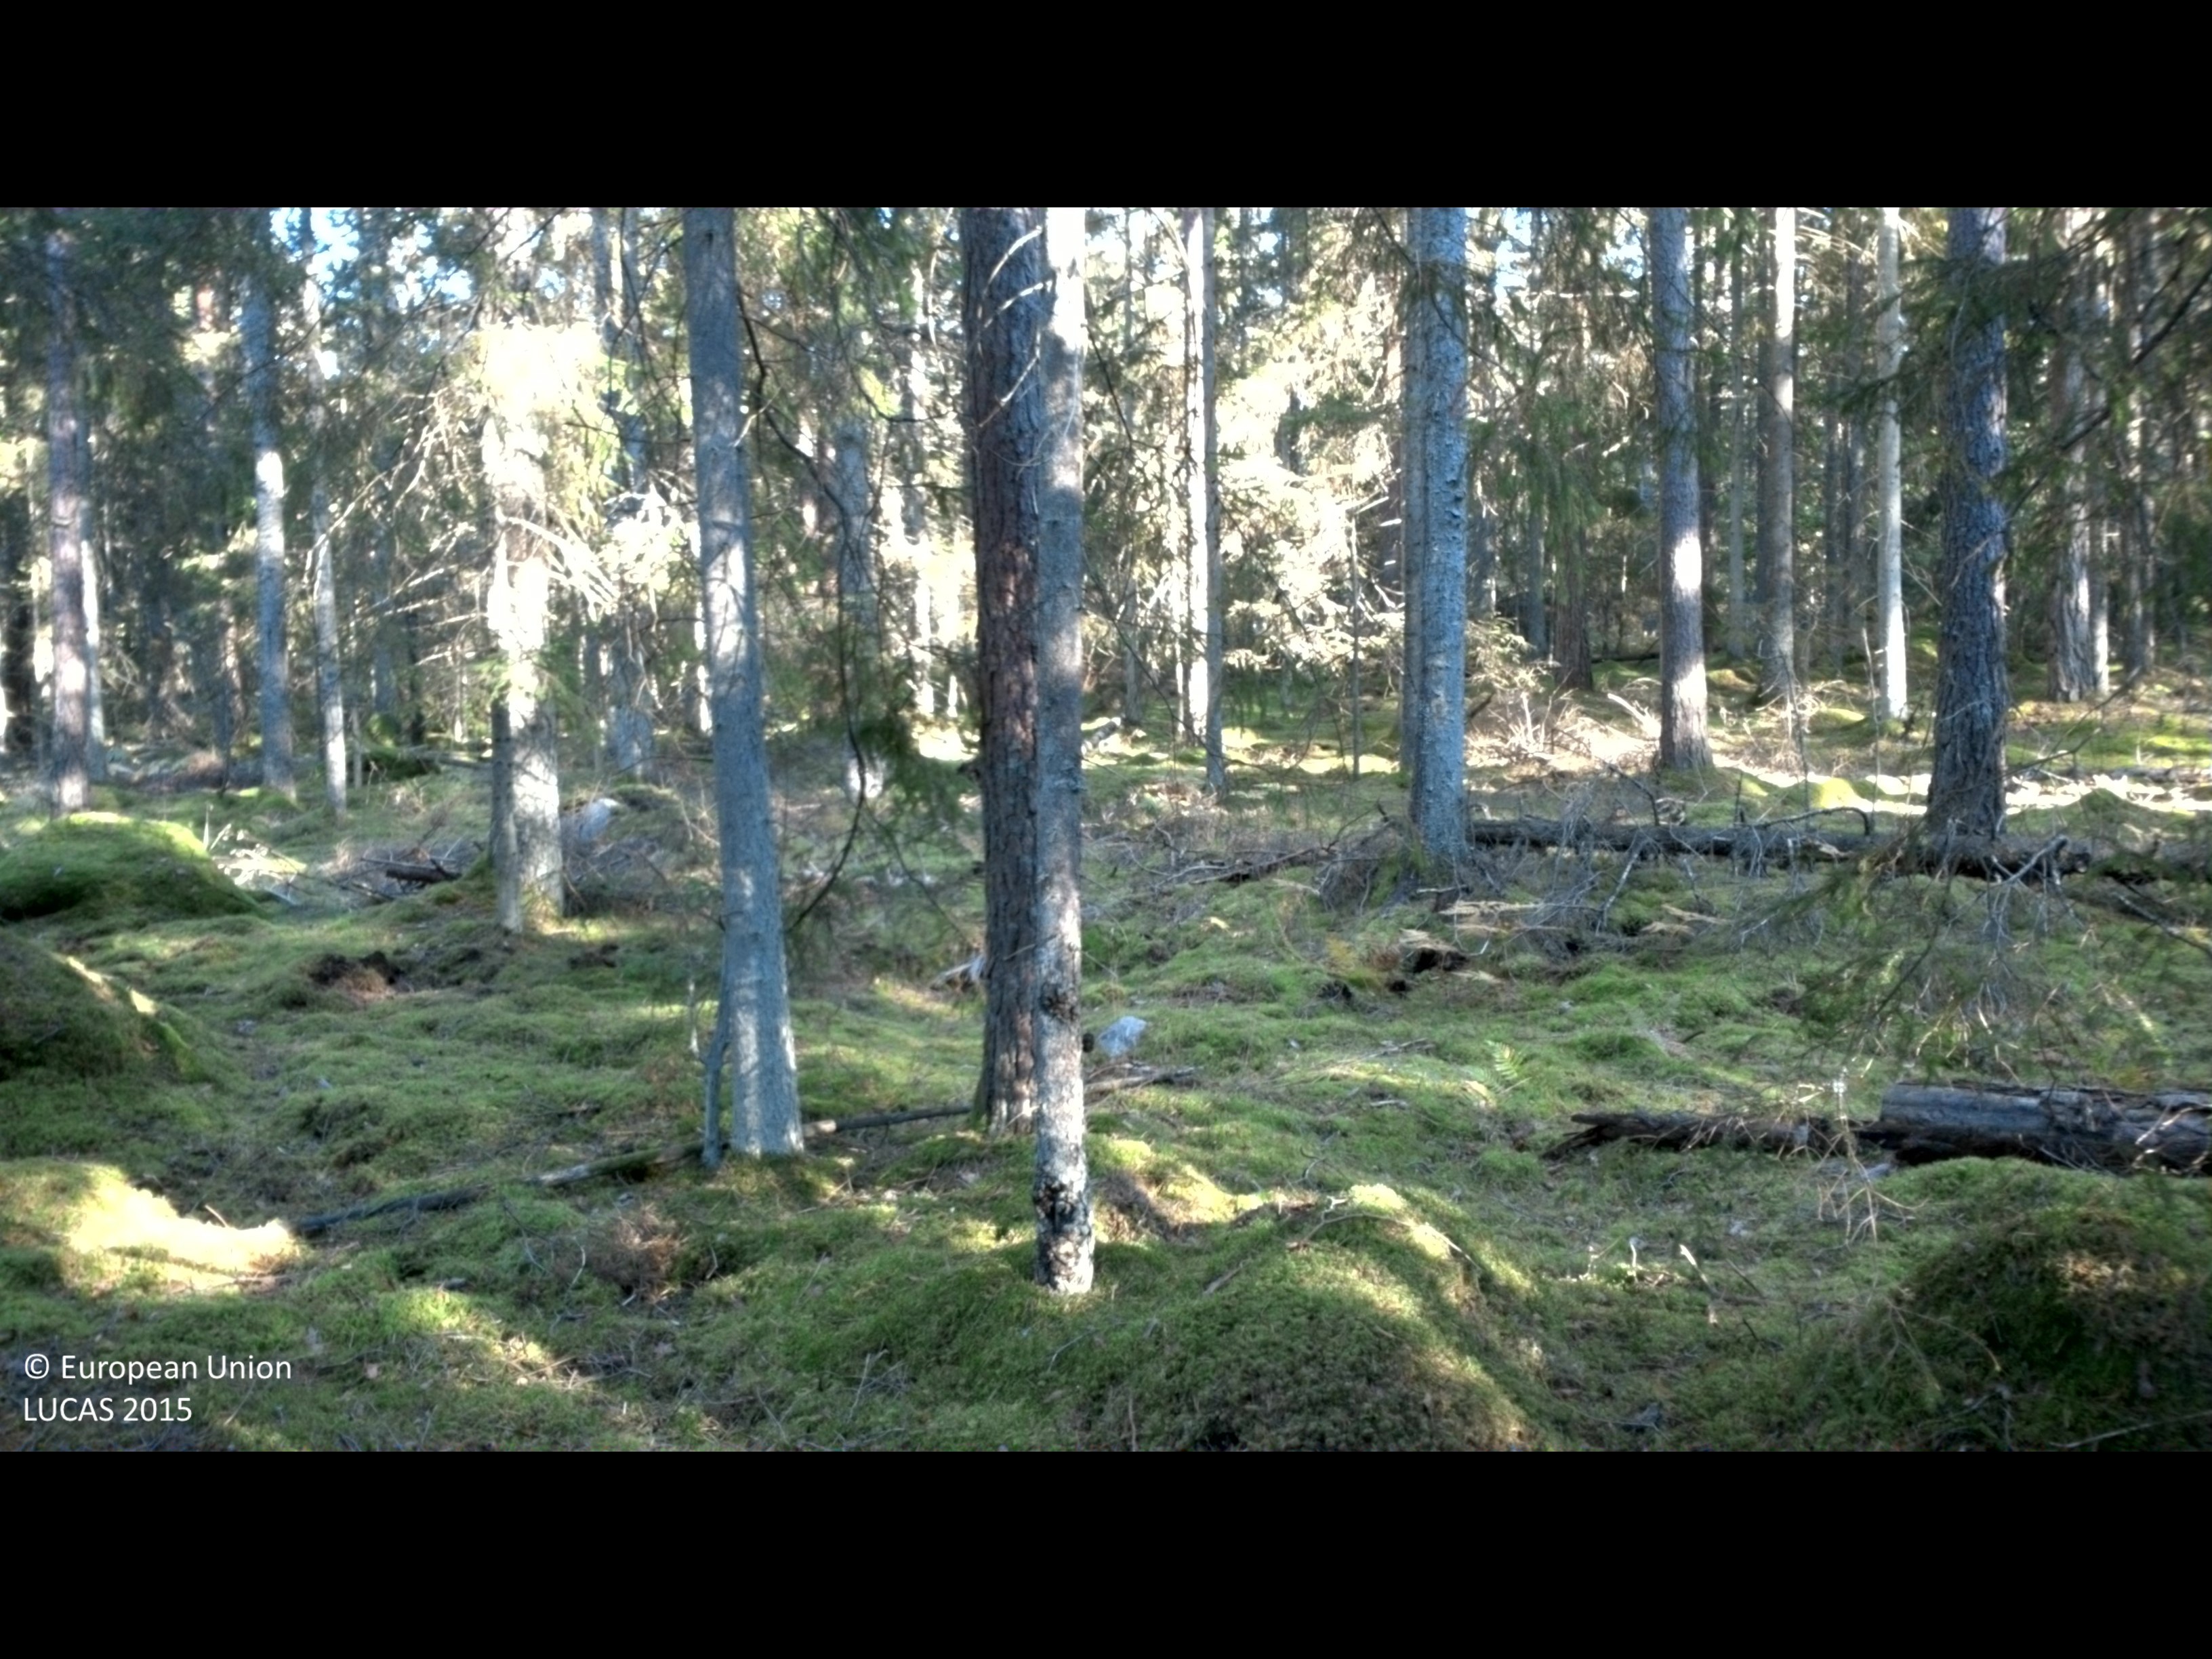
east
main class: Woodland
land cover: Spruce dominated coniferous woodland
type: boreal forest
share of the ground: > 75 %
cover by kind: coniferous forest trees 75 %, lichens and mosses 15 %, shrubs 10 %
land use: Forestry
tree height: > 5 m
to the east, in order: Spruce dominated coniferous woodland; Paved roads, cycling and walking lanes; Pine dominated coniferous woodland
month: September
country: SE
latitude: 56.3171
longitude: 15.1885
